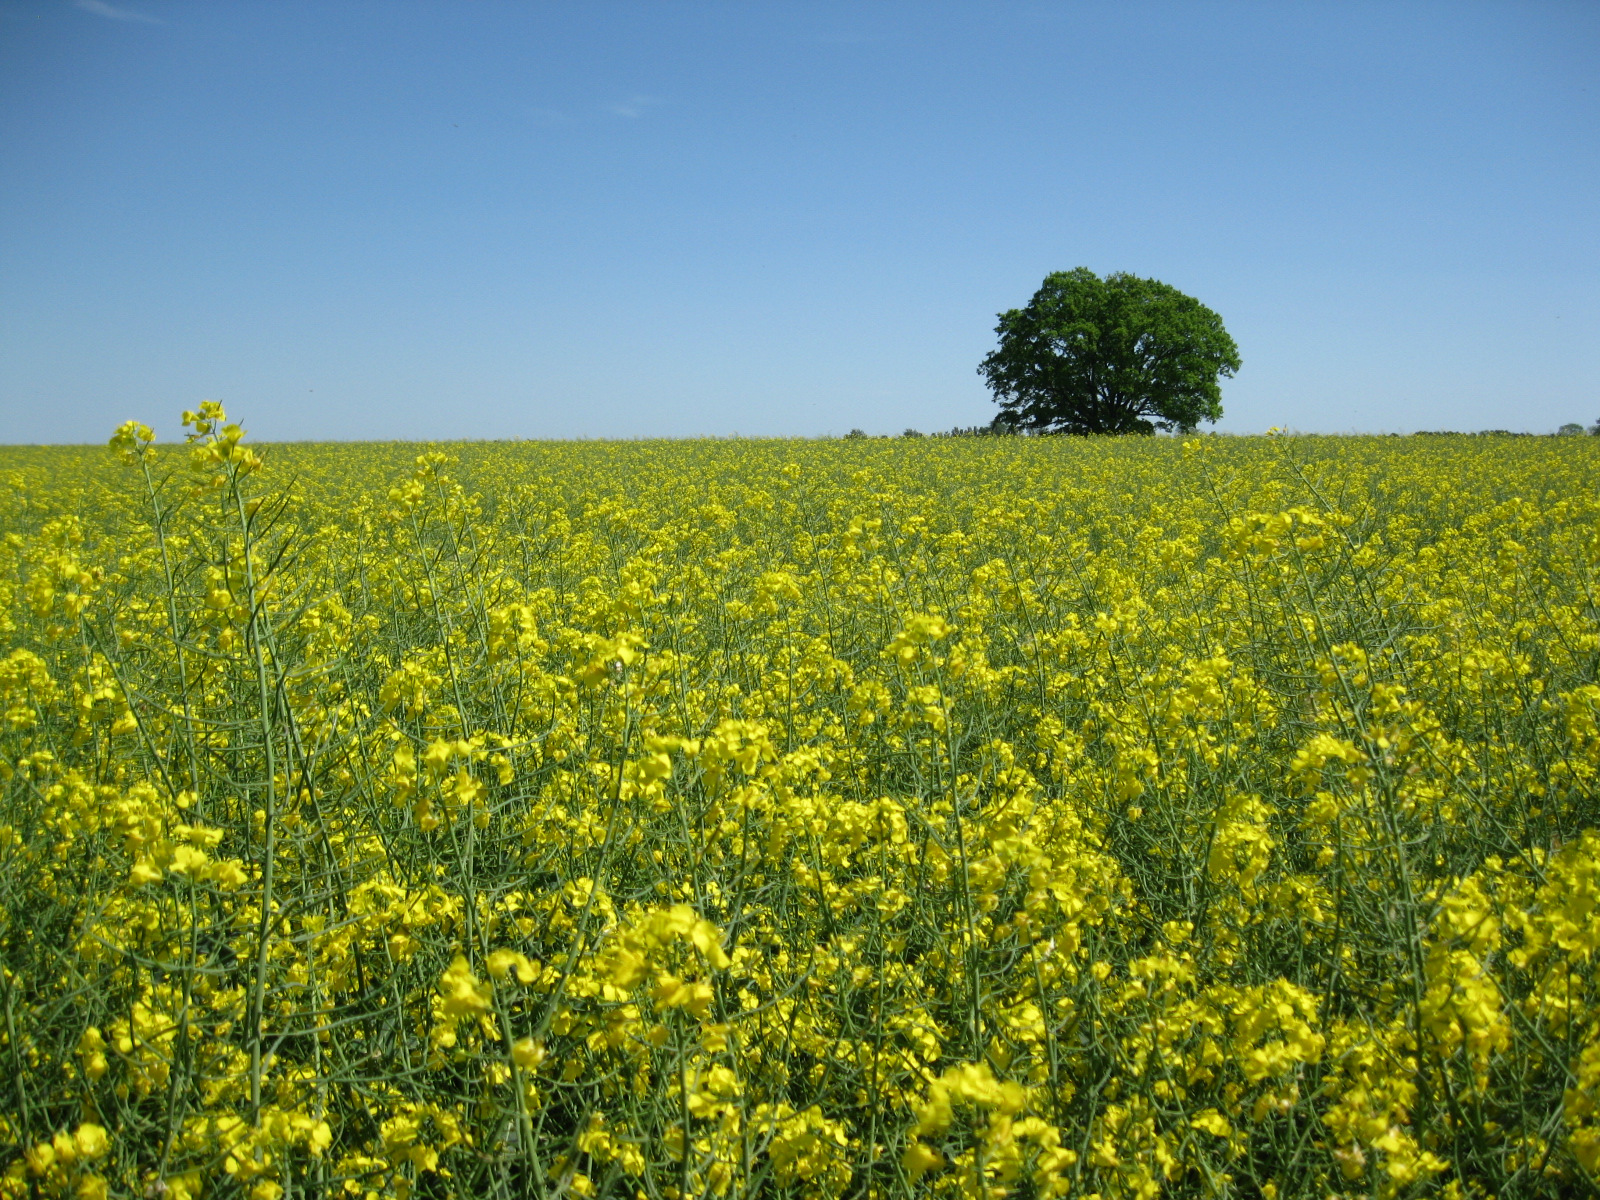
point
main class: Cropland
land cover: Rape and turnip rape
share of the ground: > 75 %
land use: Agriculture (excluding fallow land and kitchen gardens)
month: June
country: LT
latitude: 55.9550
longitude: 23.7439
